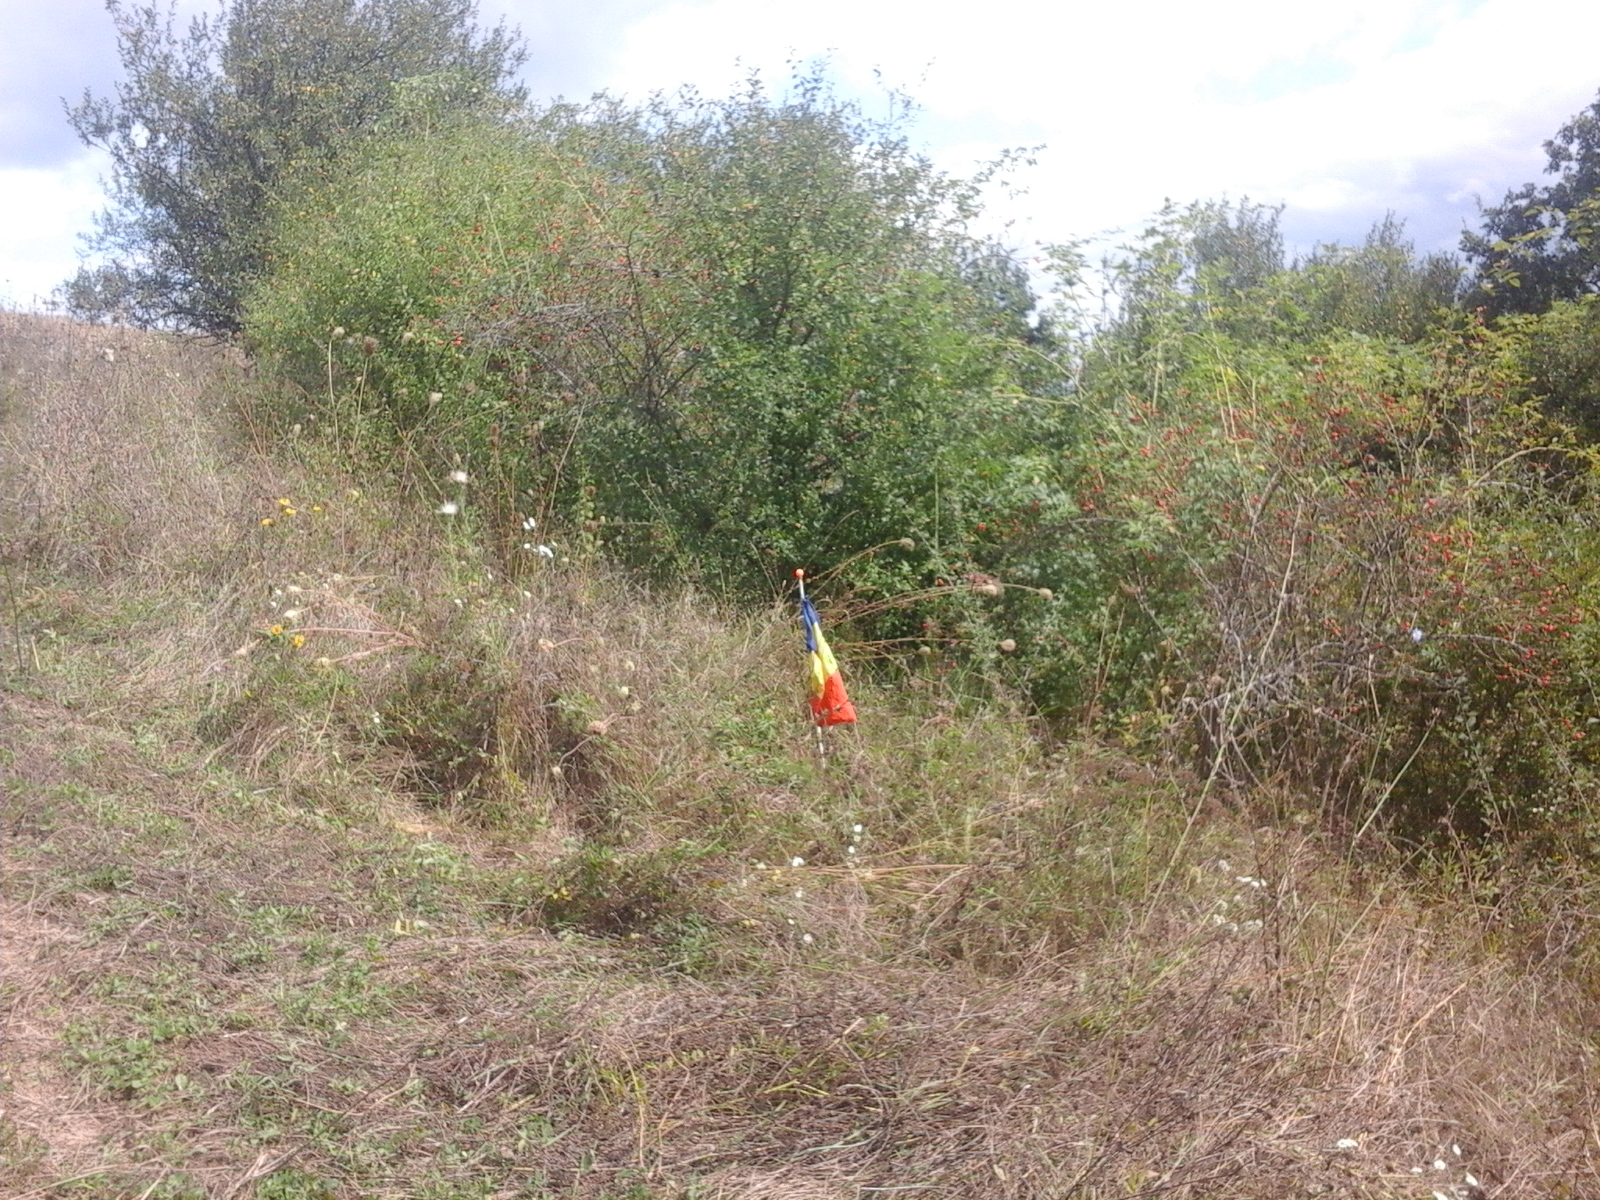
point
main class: Grassland
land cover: Grassland with sparse tree/shrub cover
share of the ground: > 75 %
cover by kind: herbaceous plants 85 %, shrubs 10 %, broadleaved forest trees 5 %
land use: Fallow land
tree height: < 5 m
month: September
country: RO
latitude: 47.3663
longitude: 23.6755
